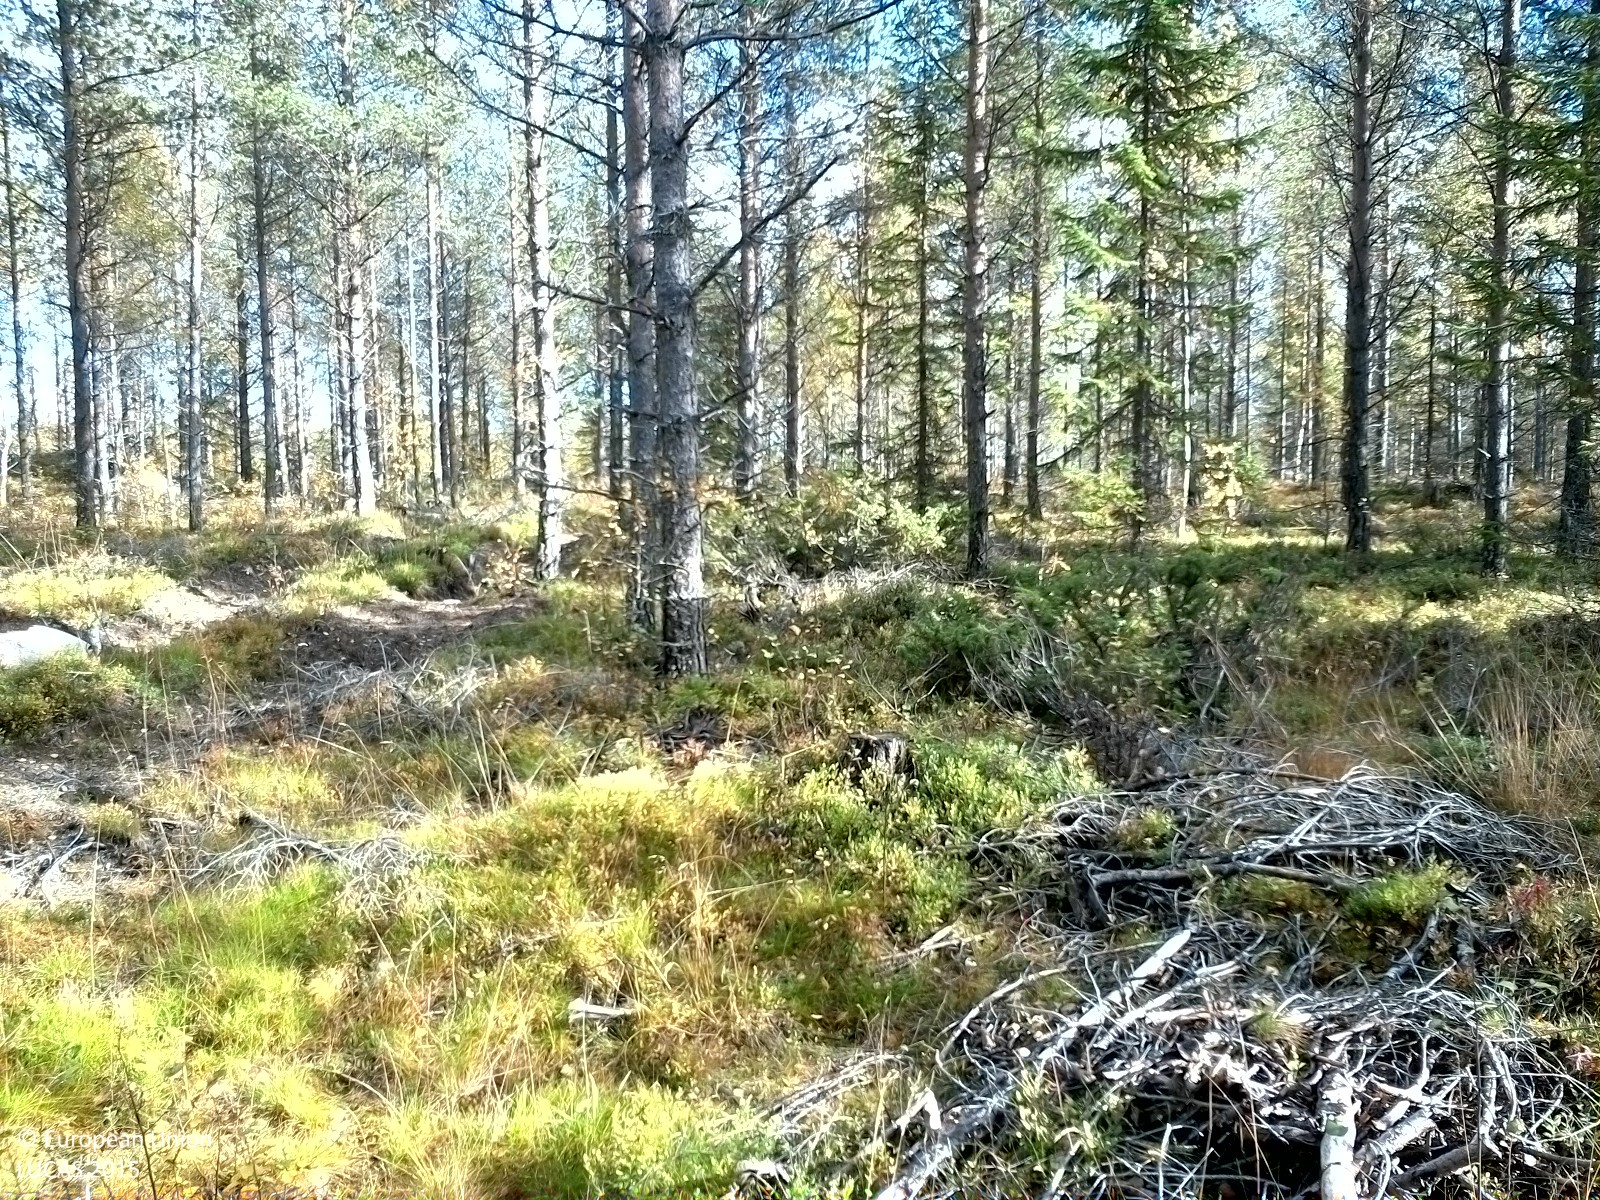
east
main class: Woodland
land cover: Spruce dominated mixed woodland
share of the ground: 50 - 75 %
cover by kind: broadleaved forest trees 35 %, lichens and mosses 30 %, shrubs 20 %, coniferous forest trees 15 %
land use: Forestry
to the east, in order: Spruce dominated mixed woodland; Pine dominated coniferous woodland; Tracks; Pine dominated coniferous woodland; Other mixed woodland; Broadleaved woodland
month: September
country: SE
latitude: 62.1025
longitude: 15.3268
